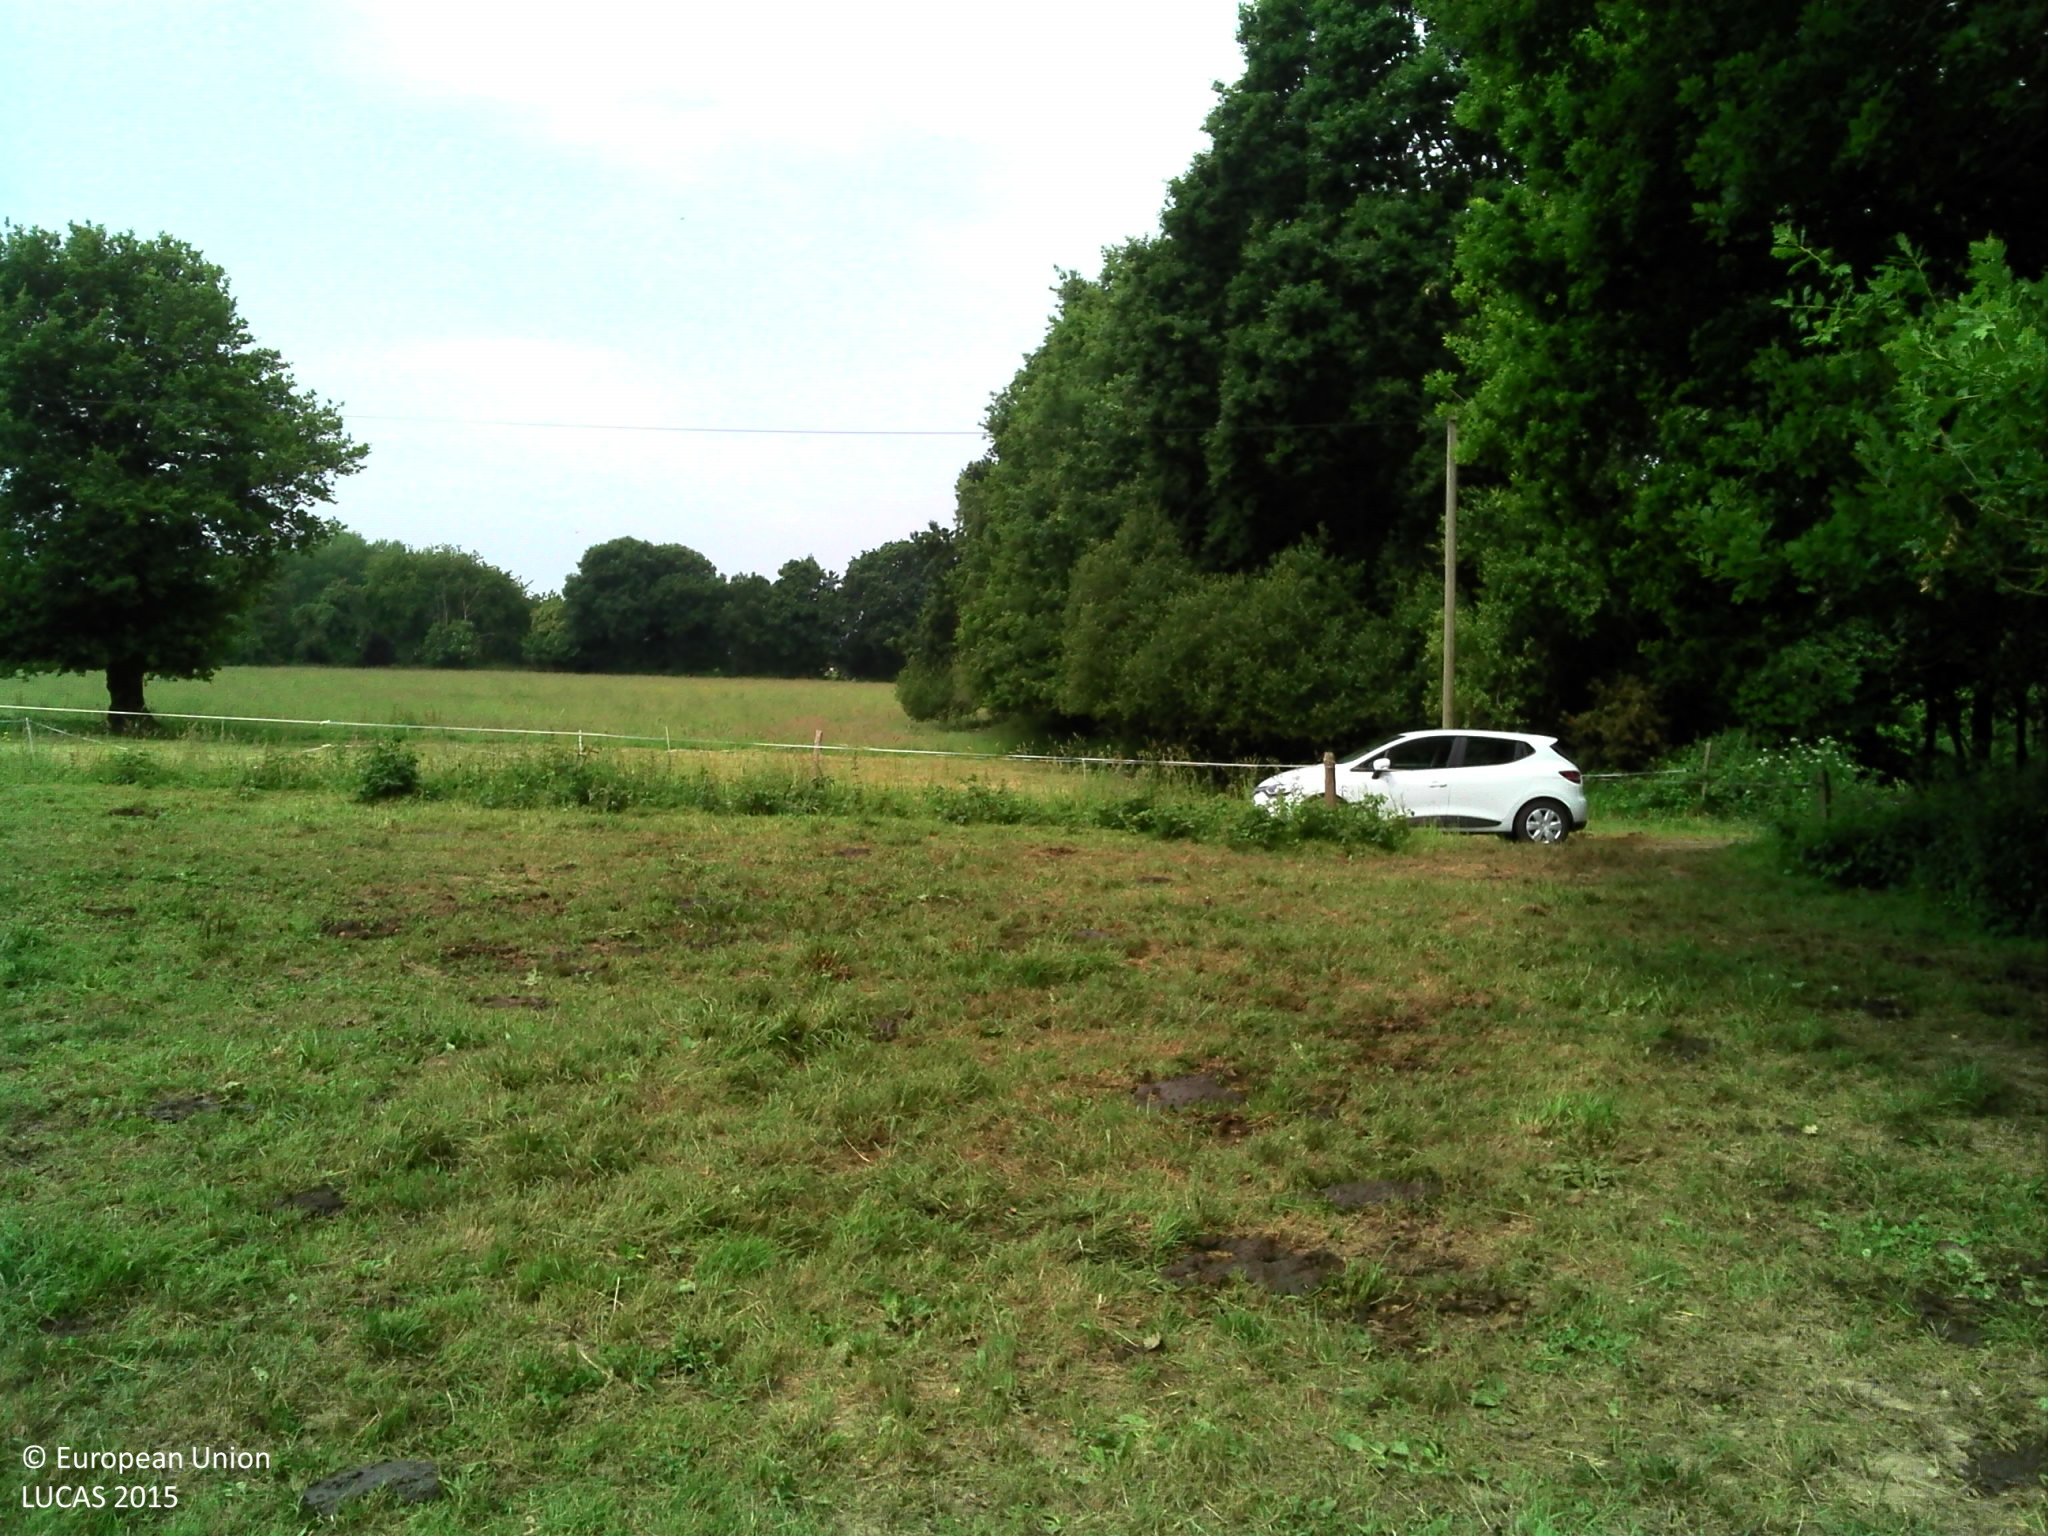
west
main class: Grassland
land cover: Grassland without tree/shrub cover
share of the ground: > 75 %
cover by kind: herbaceous plants 100 %
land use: Agriculture (excluding fallow land and kitchen gardens)
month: June
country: FR
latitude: 48.1503
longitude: -2.1387
